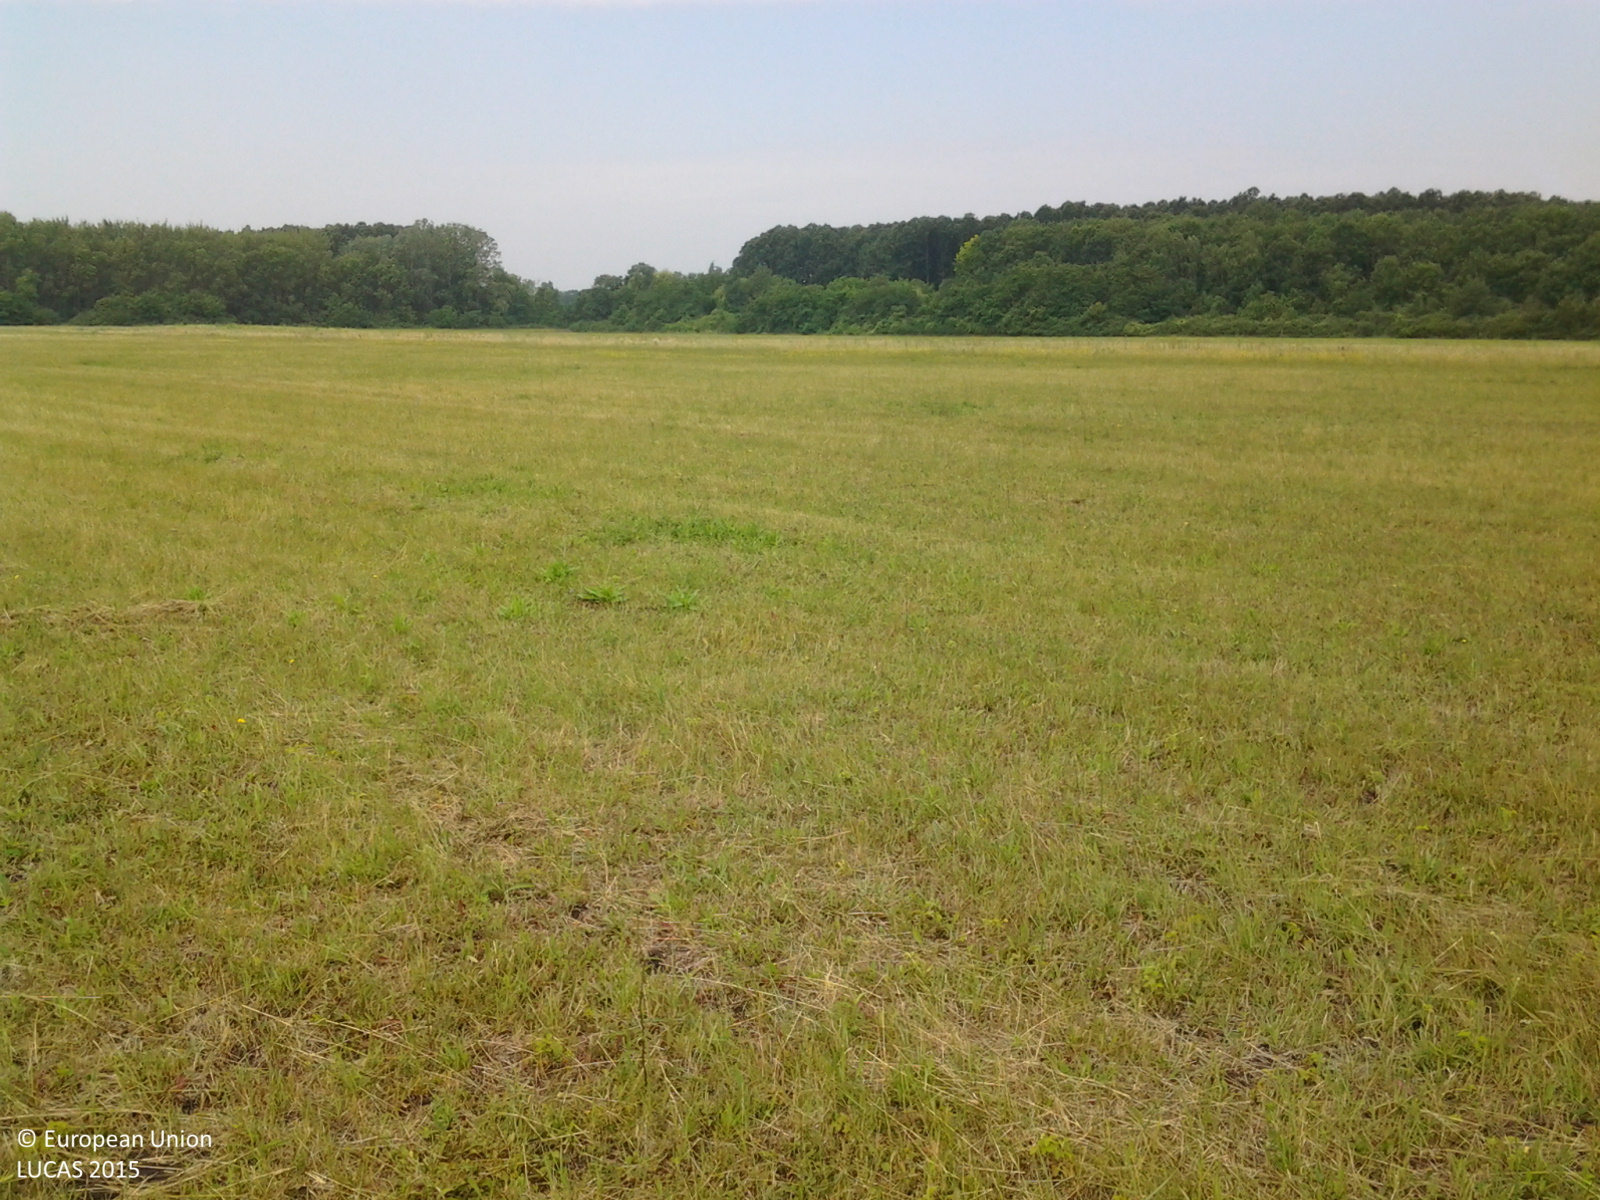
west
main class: Grassland
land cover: Grassland without tree/shrub cover
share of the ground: > 75 %
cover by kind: herbaceous plants 100 %
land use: Agriculture (excluding fallow land and kitchen gardens)
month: June
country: HU
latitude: 46.6864
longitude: 21.2144
